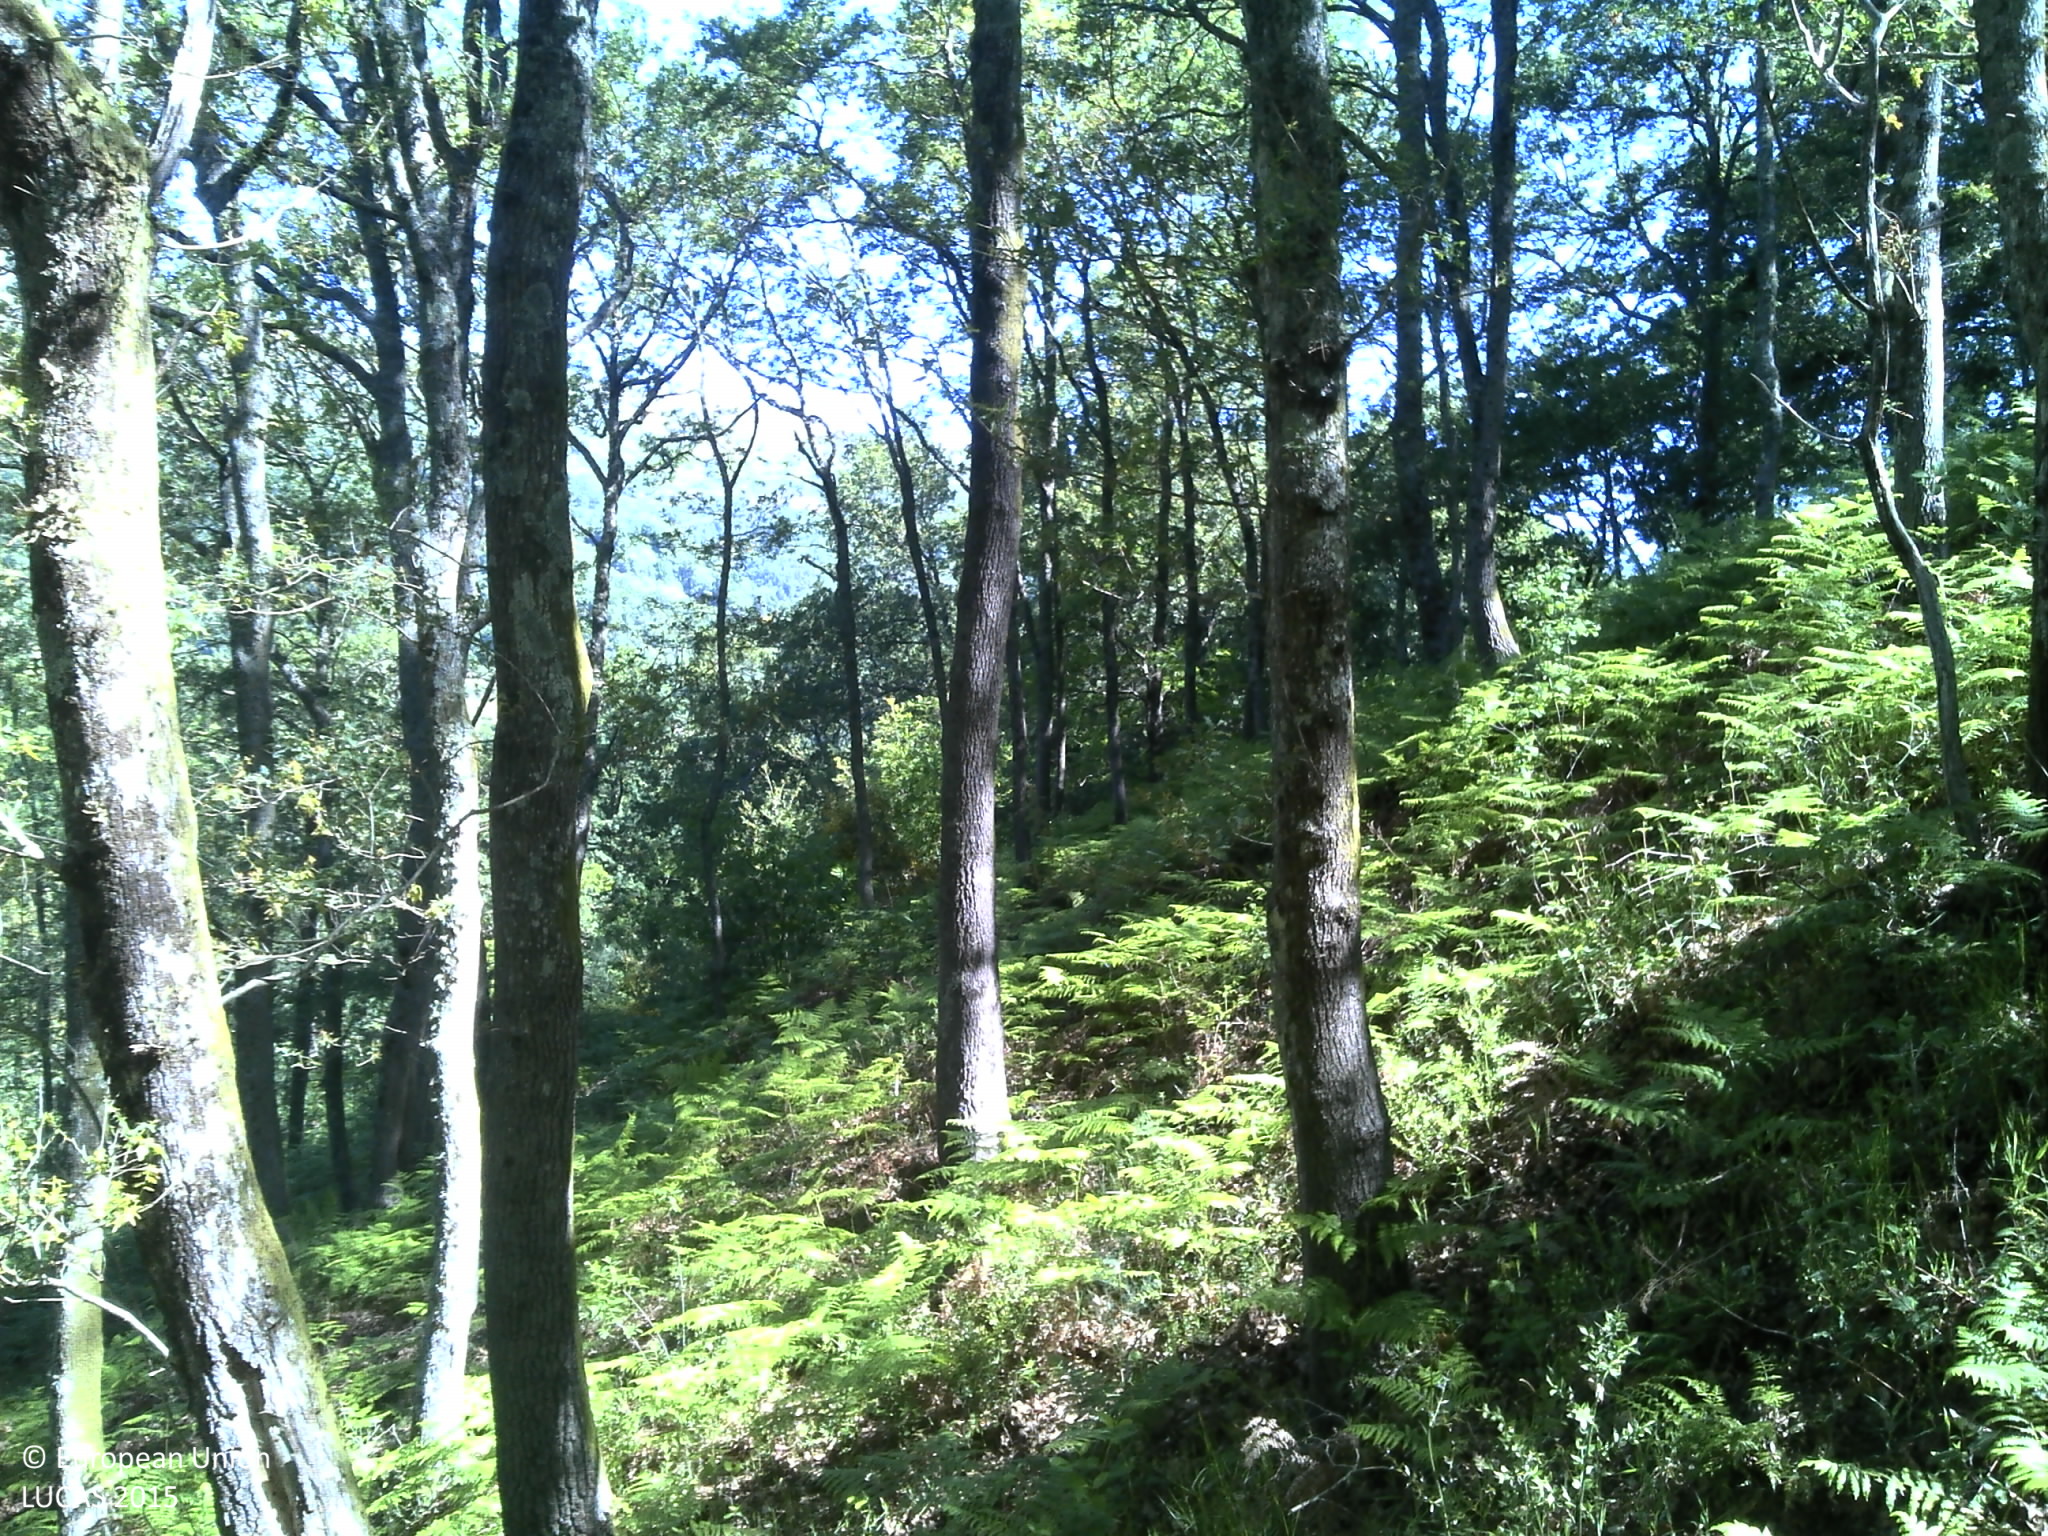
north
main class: Woodland
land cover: Broadleaved woodland
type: thermophilous deciduous forest
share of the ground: 50 - 75 %
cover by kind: broadleaved forest trees 75 %, shrubs 10 %, unconsolidated bare surface 10 %, herbaceous plants 5 %
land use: Forestry
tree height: > 5 m
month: May
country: PT
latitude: 40.9408
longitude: -7.9591
